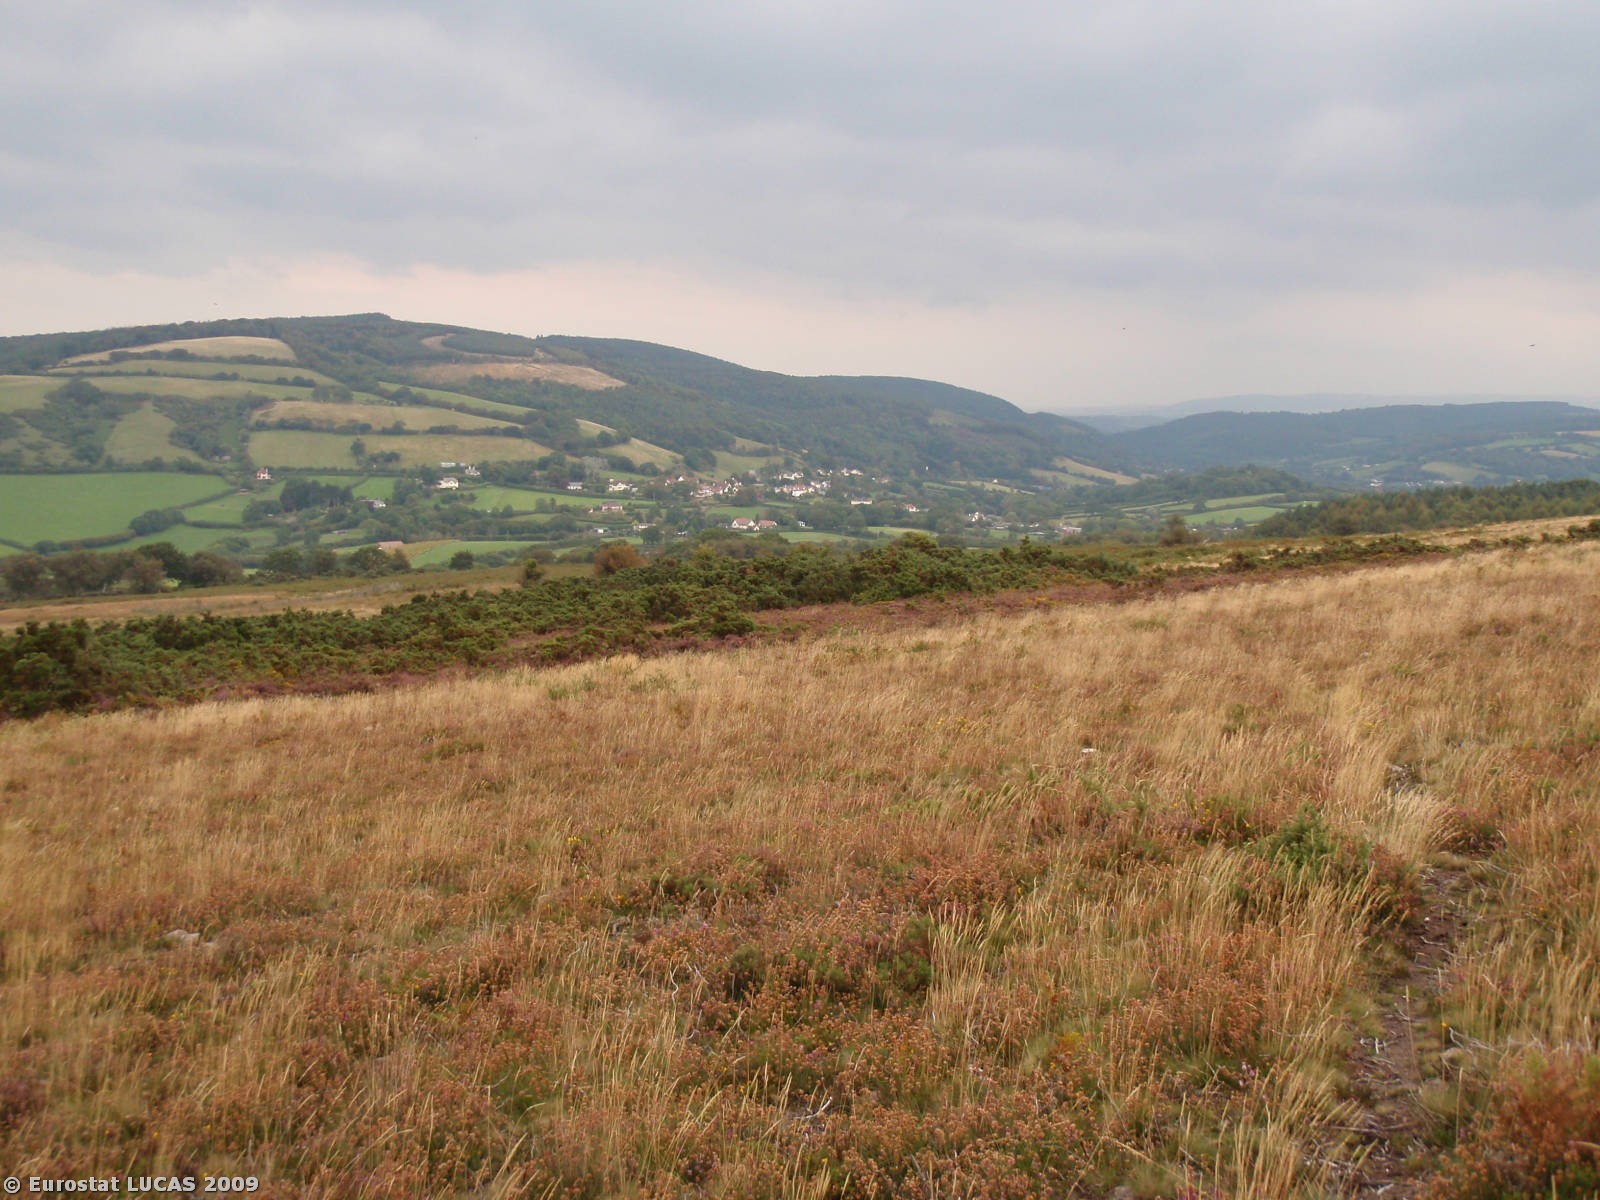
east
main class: Shrubland
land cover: Shrubland without tree cover
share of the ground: 25 - 50 %
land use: Agriculture (excluding fallow land and kitchen gardens)
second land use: Amenities, museums, leisure
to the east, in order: Shrubland without tree cover; Grassland without tree/shrub cover; Shrubland without tree cover; Tracks; Grassland without tree/shrub cover
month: September
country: GB
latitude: 51.1768
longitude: -3.5455
